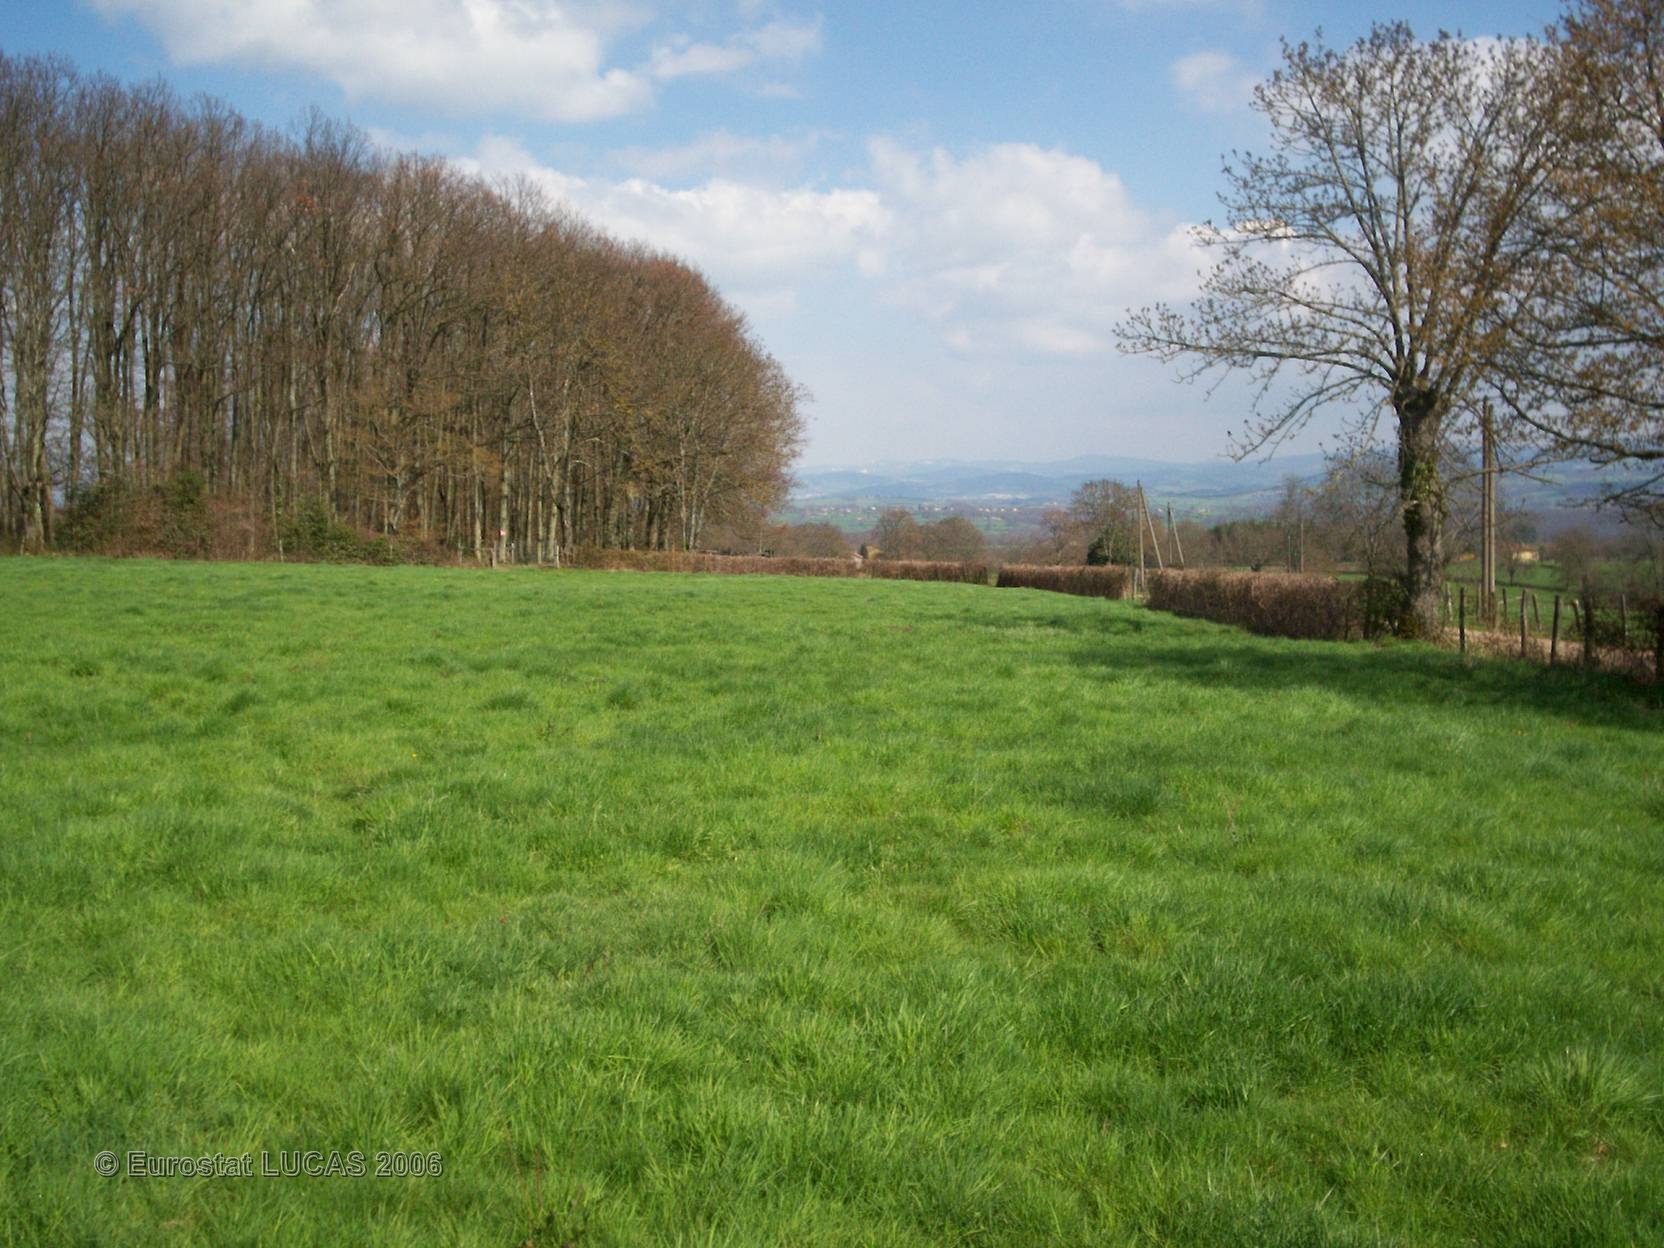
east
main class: Grassland
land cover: Grassland without tree/shrub cover
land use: Agriculture (excluding fallow land and kitchen gardens)
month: April
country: FR
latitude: 46.1901
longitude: 4.1319
